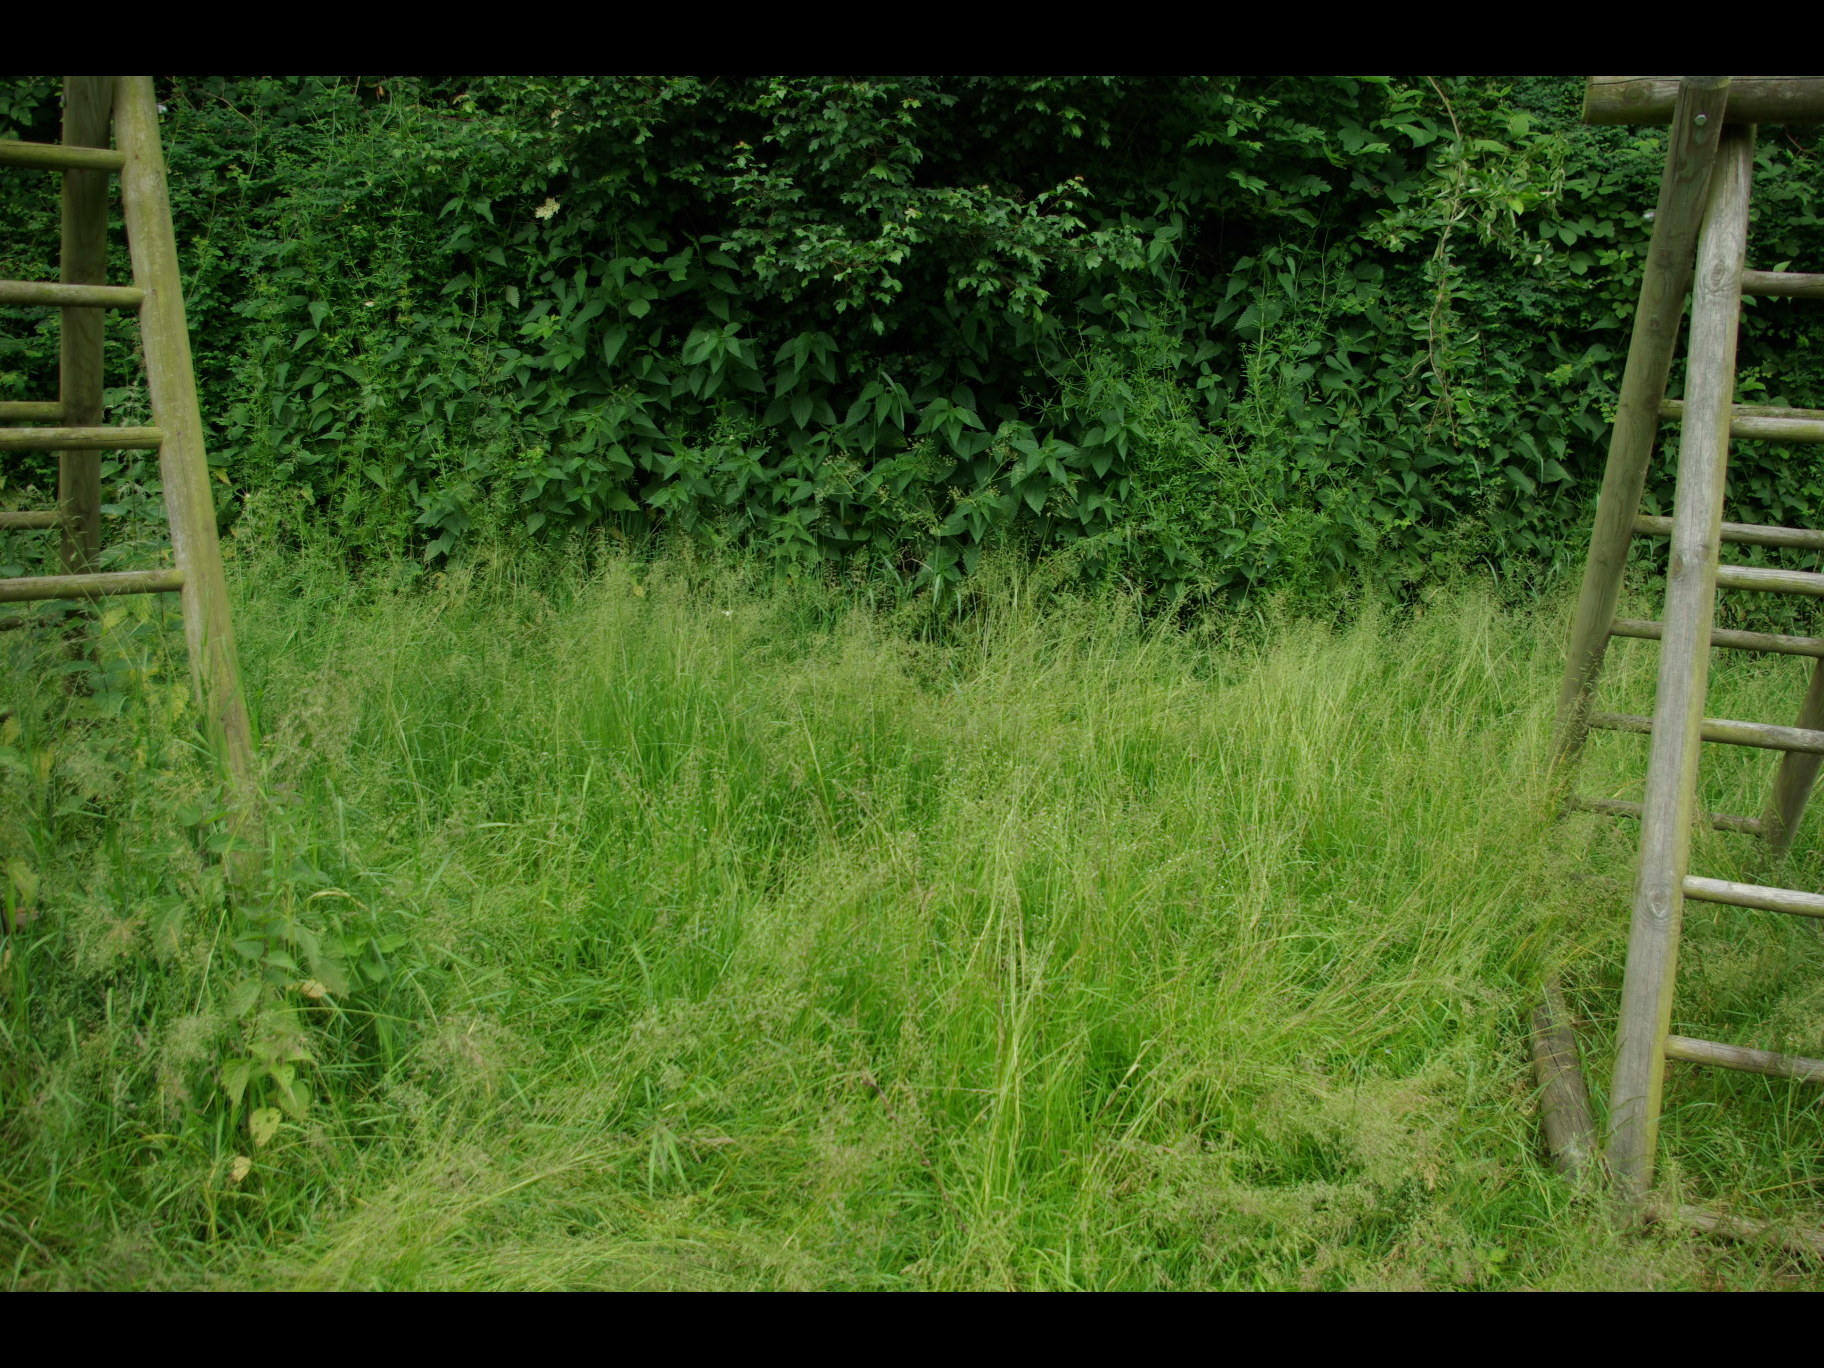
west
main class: Grassland
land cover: Grassland without tree/shrub cover
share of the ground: > 75 %
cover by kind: herbaceous plants 95 %, shrubs 5 %
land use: Residential
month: June
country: DE
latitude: 54.4622
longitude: 9.8304
